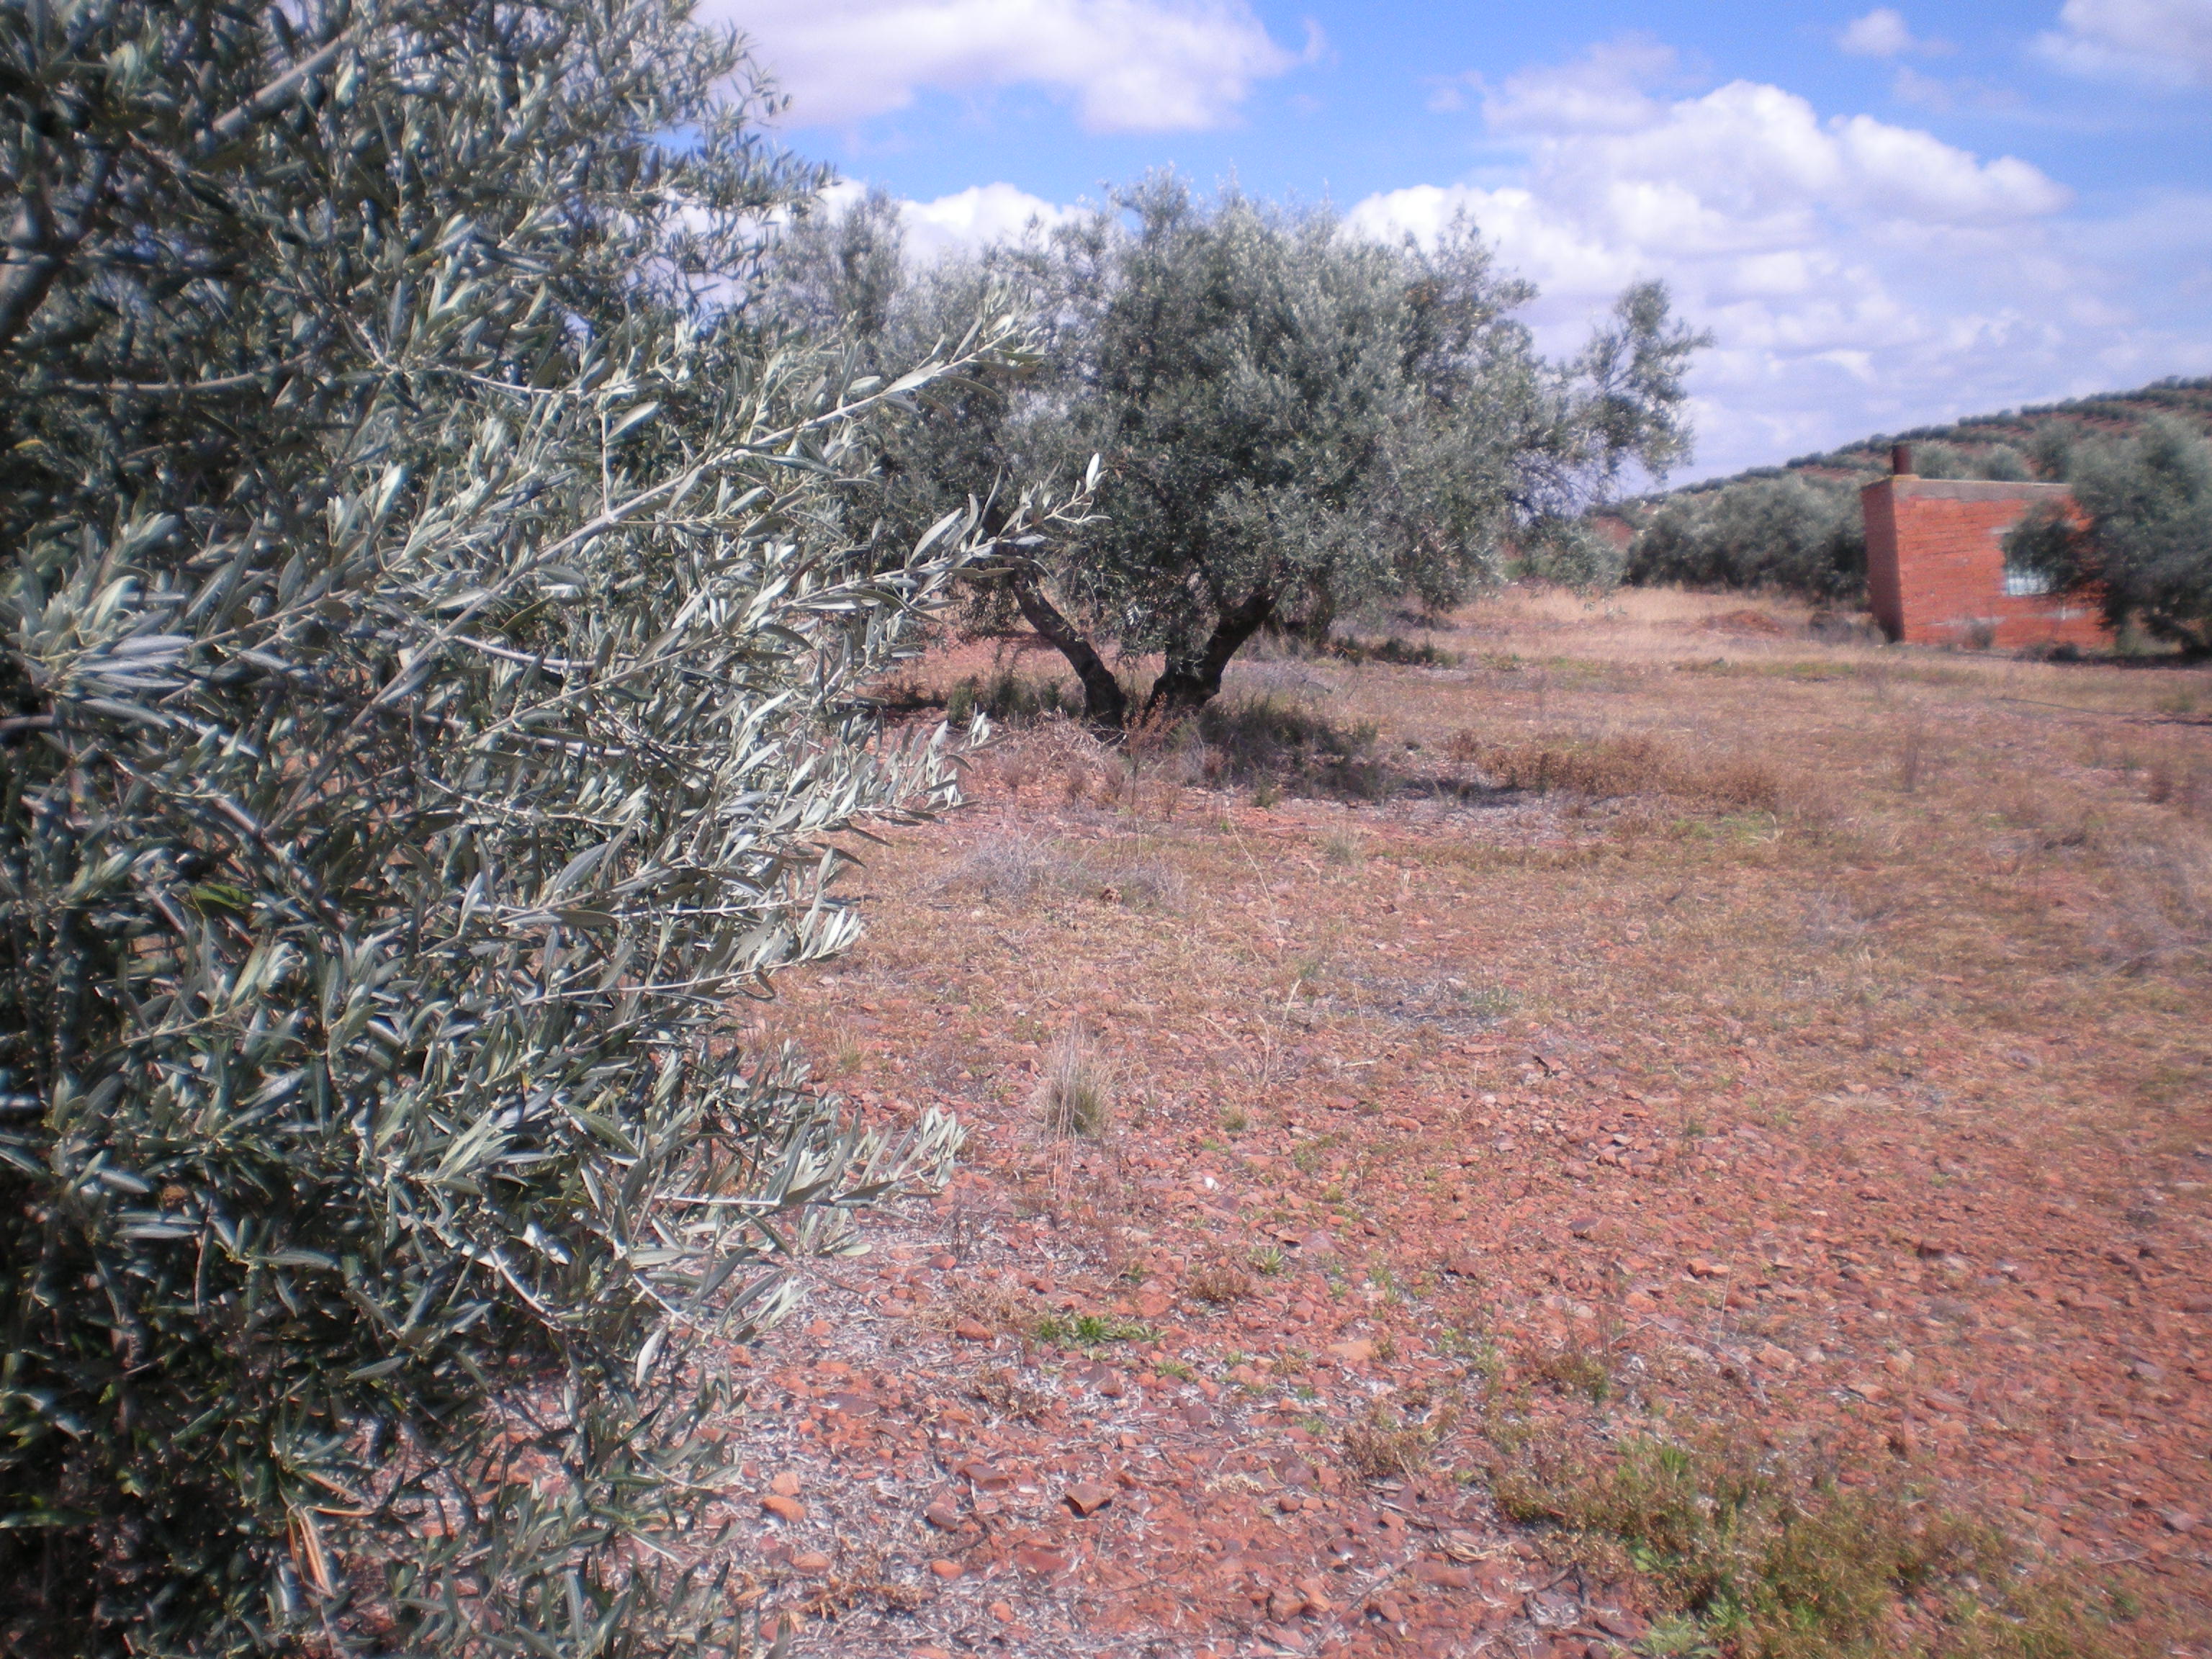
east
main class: Cropland
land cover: Olive groves
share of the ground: 25 - 50 %
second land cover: Other bare soil
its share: > 75 %
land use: Agriculture (excluding fallow land and kitchen gardens)
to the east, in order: Olive groves; Other bare soil; Grass margins; Dry stone walls; Grass margins; Oats
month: April
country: ES
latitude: 38.7567
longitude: -3.5337
